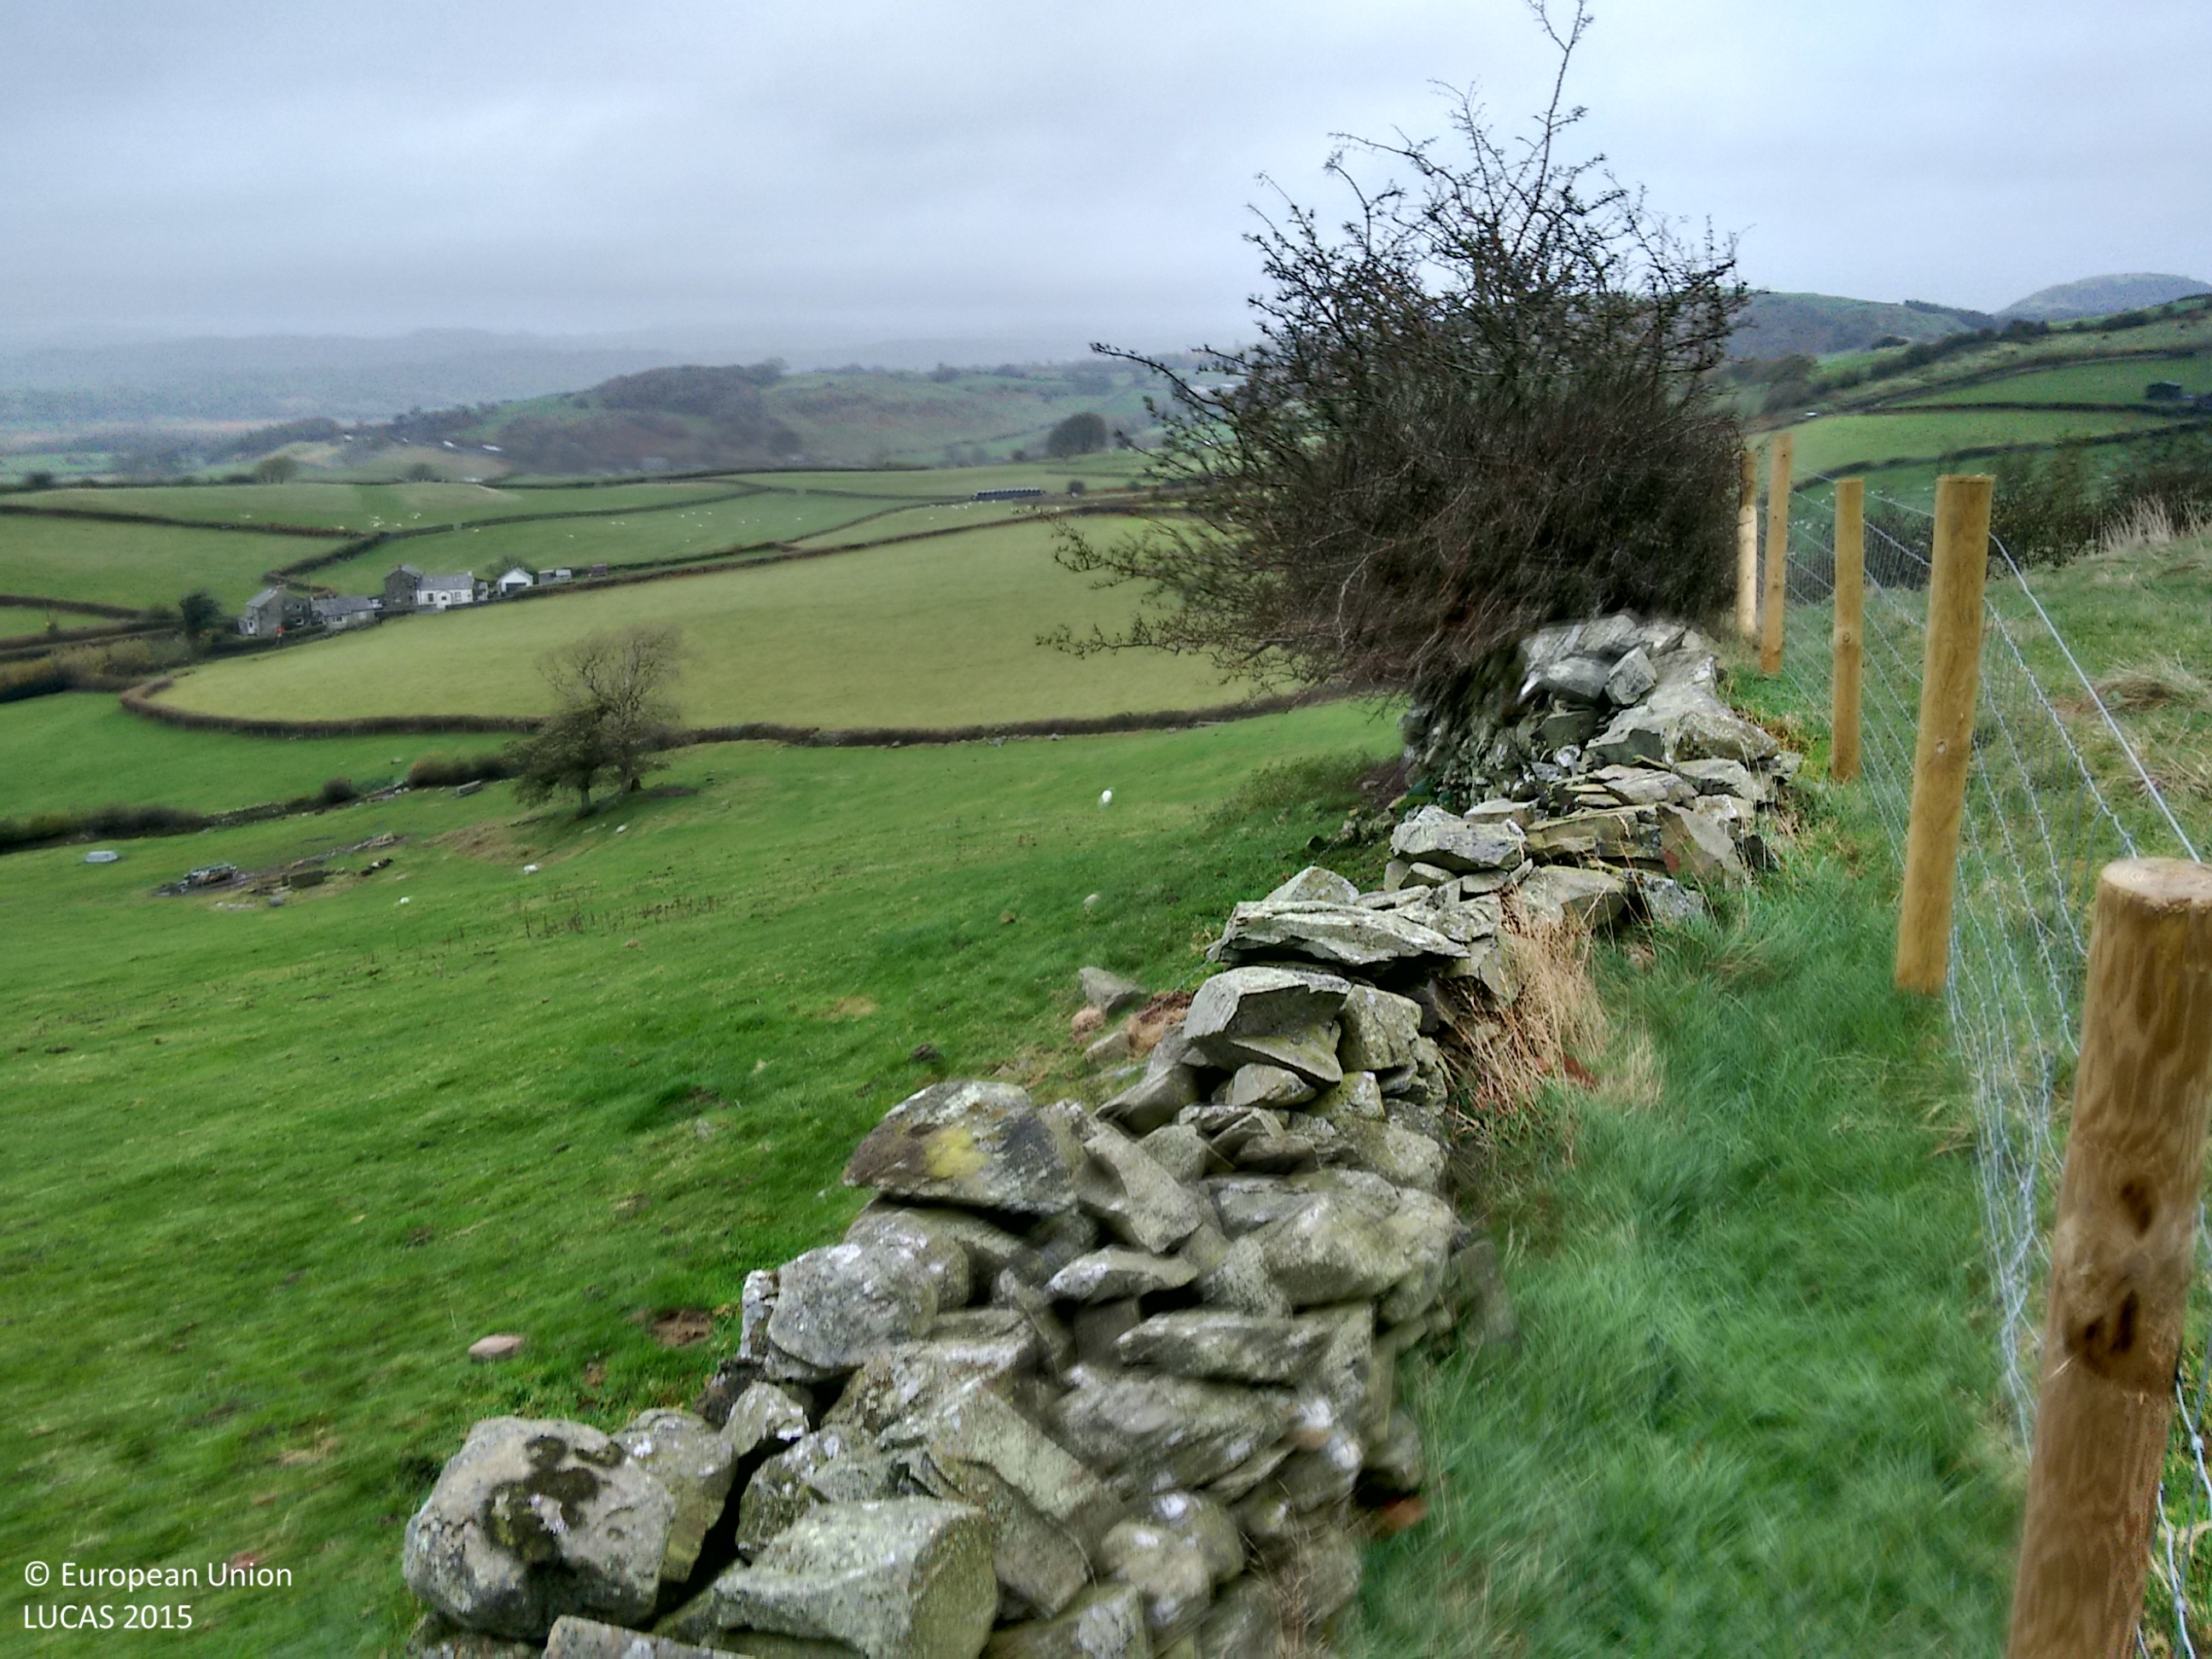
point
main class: Grassland
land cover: Grassland without tree/shrub cover
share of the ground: > 75 %
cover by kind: herbaceous plants 100 %
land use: Agriculture (excluding fallow land and kitchen gardens)
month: November
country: GB
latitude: 54.2468
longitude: -3.1667
